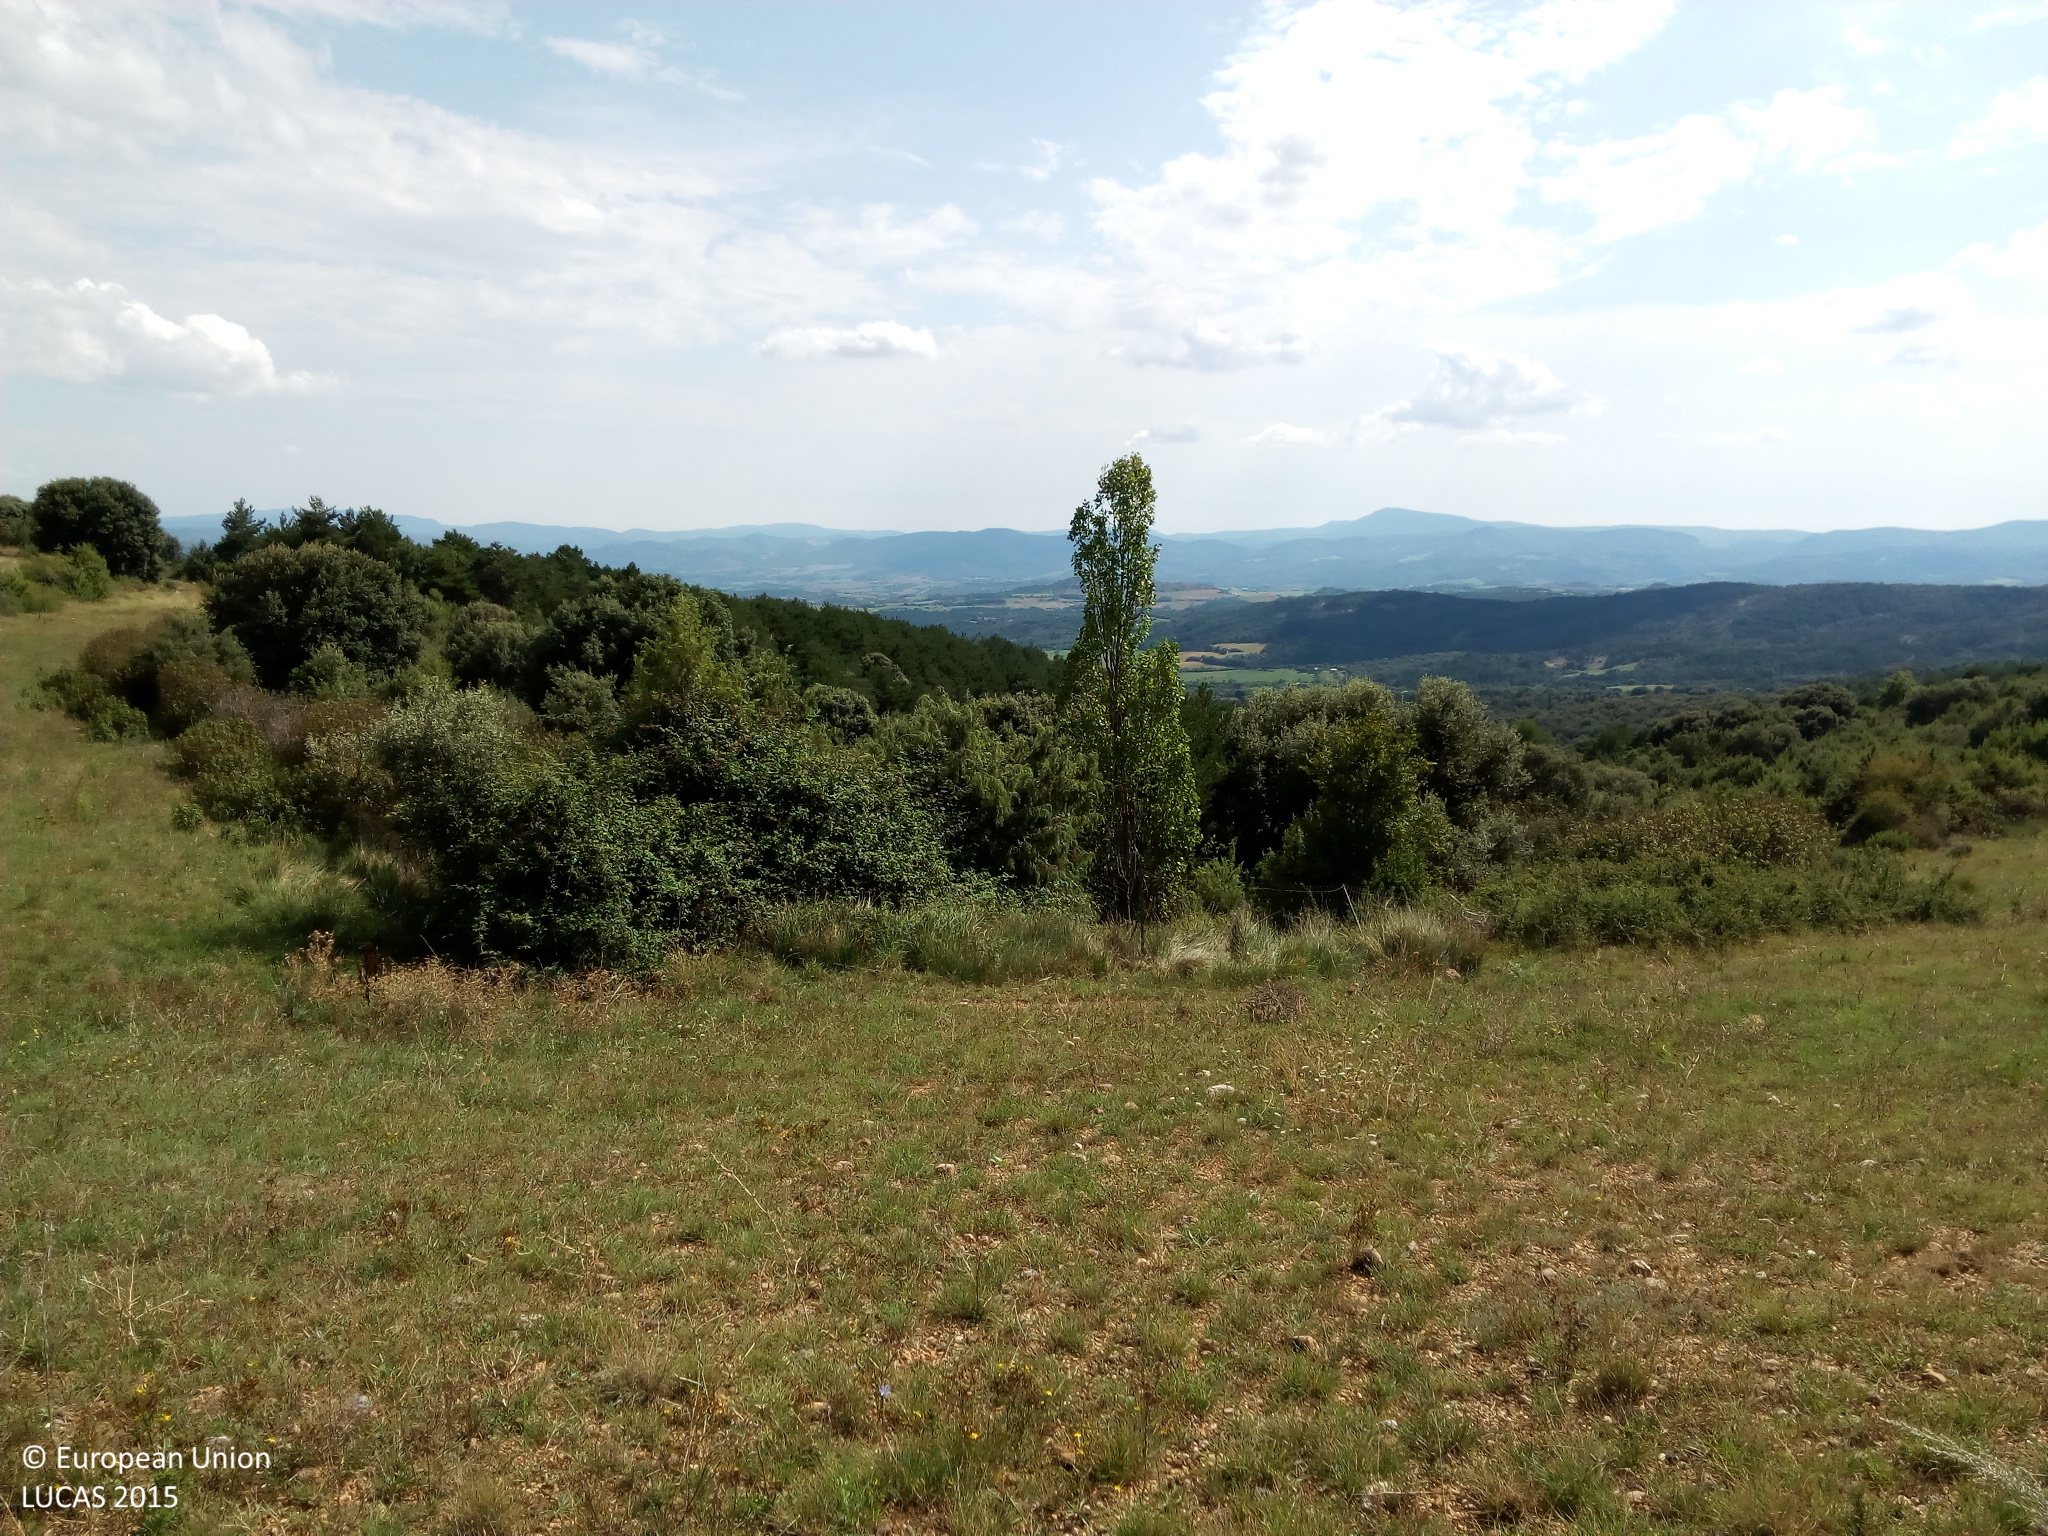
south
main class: Grassland
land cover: Grassland without tree/shrub cover
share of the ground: > 75 %
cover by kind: unconsolidated bare surface 60 %, herbaceous plants 40 %
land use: Semi-natural and natural areas not in use
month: August
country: ES
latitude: 42.1550
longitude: 0.5312
